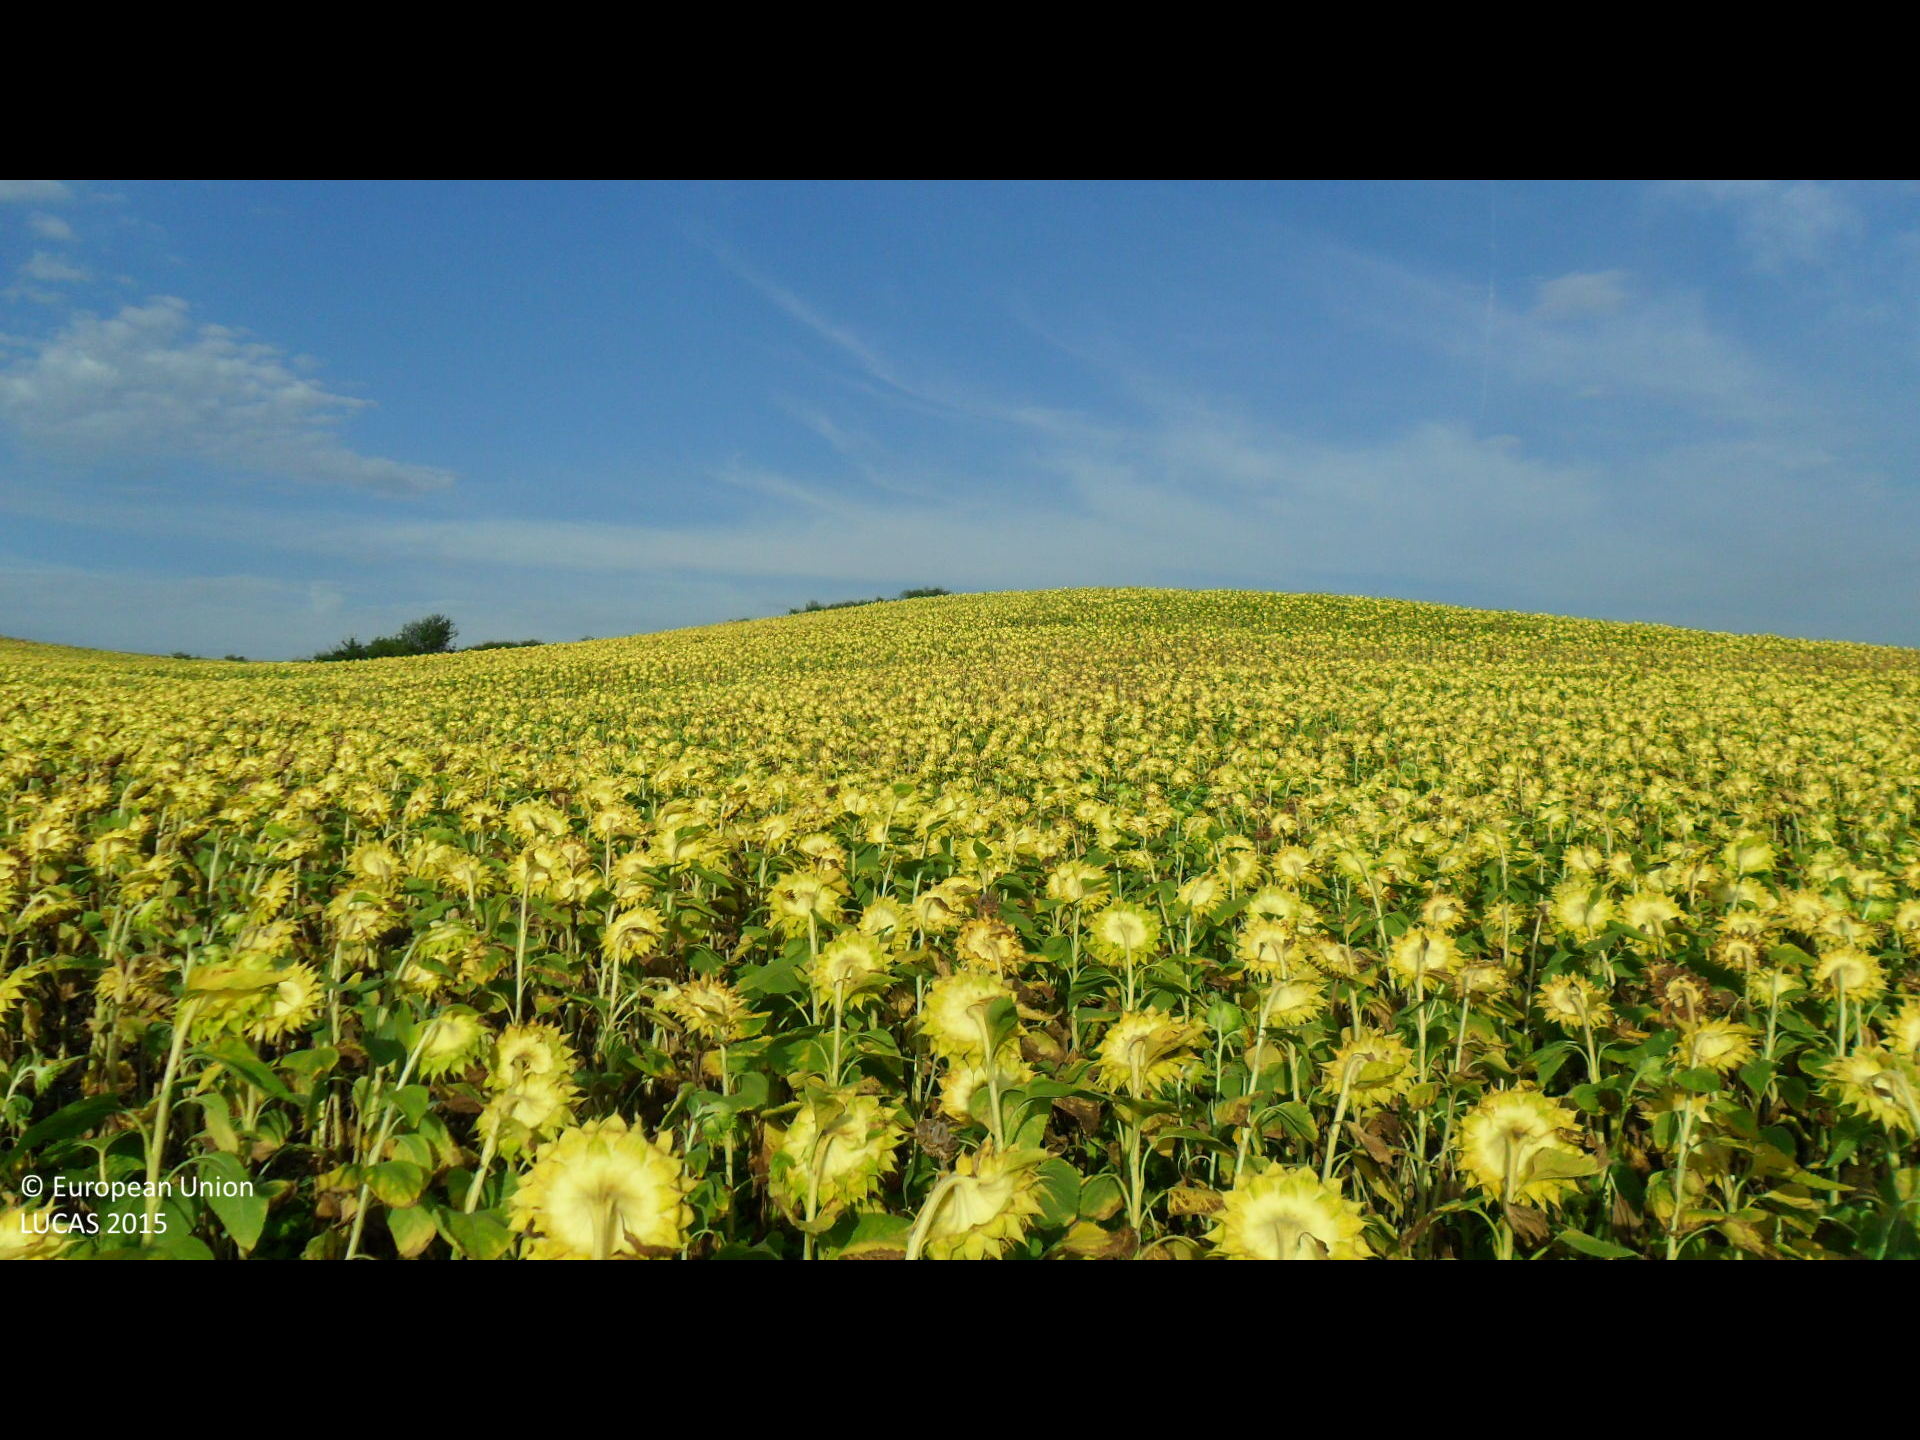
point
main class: Cropland
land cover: Sunflower
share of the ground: > 75 %
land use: Agriculture (excluding fallow land and kitchen gardens)
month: August
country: BG
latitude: 43.3692
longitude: 26.1502
